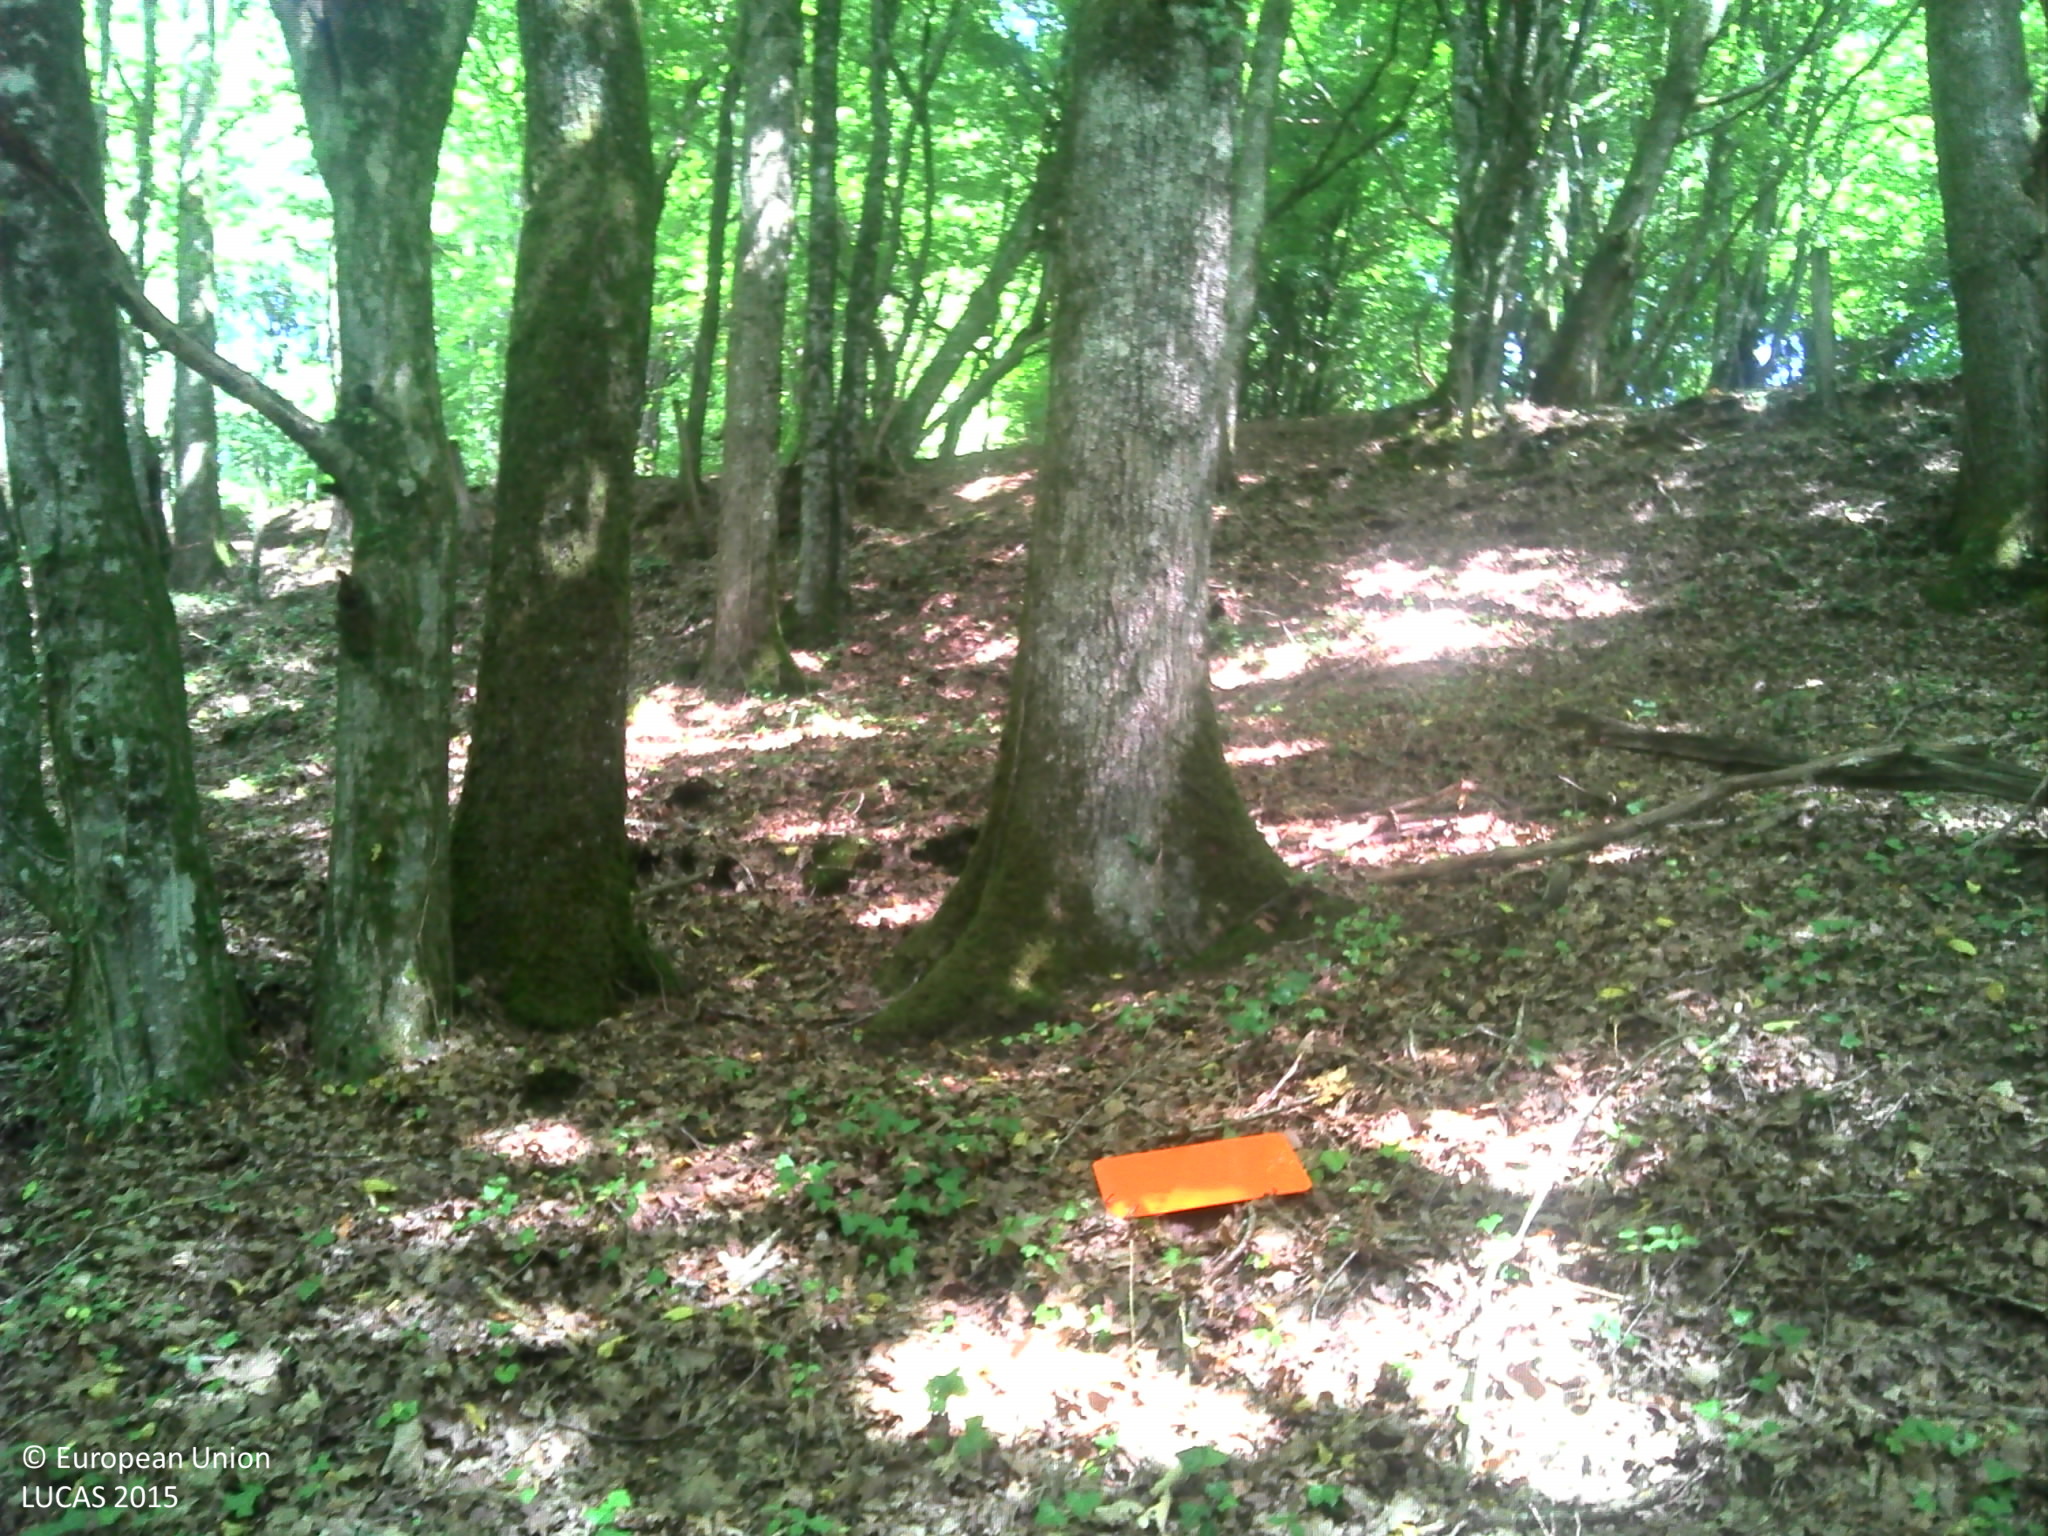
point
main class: Woodland
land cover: Broadleaved woodland
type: mesophytic deciduous forest
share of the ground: 50 - 75 %
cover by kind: broadleaved forest trees 70 %, herbaceous plants 20 %, lichens and mosses 10 %
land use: Forestry
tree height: > 5 m
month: August
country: FR
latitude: 45.2555
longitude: 1.5466
